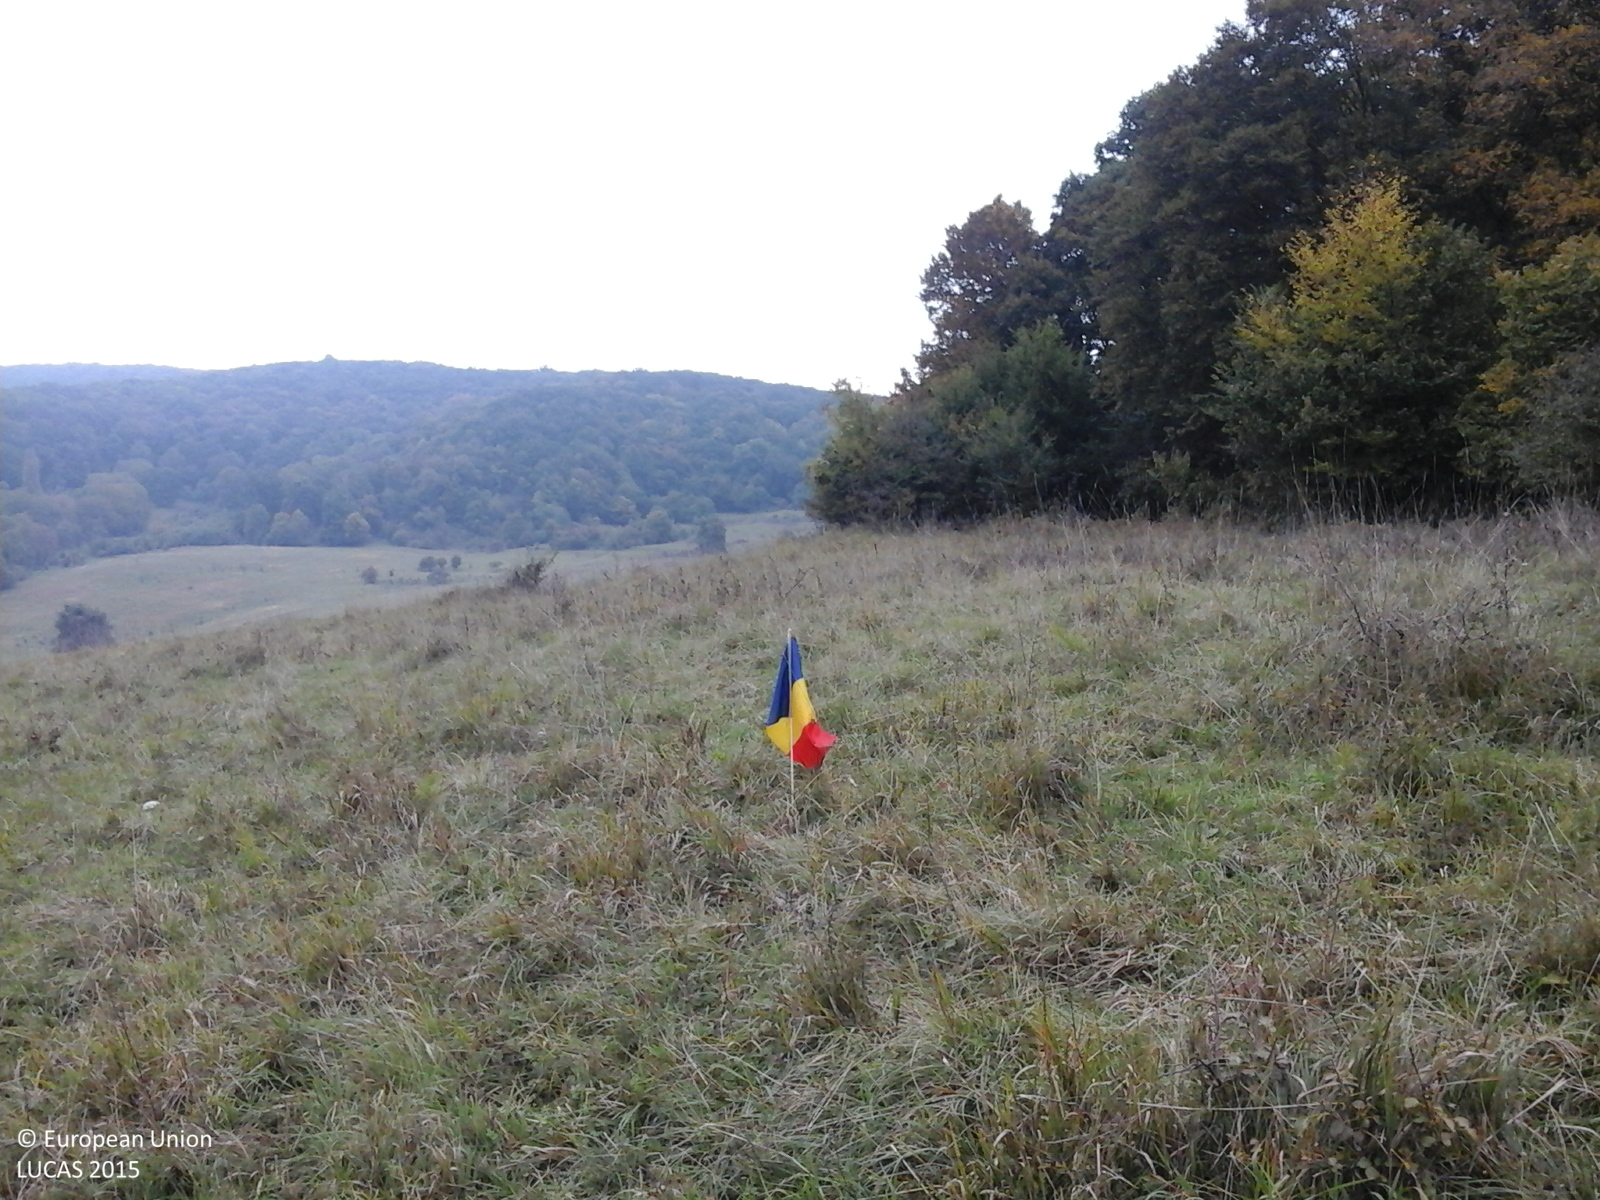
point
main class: Grassland
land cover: Grassland without tree/shrub cover
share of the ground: > 75 %
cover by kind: herbaceous plants 100 %
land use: Agriculture (excluding fallow land and kitchen gardens)
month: October
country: RO
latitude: 46.2672
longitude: 24.7919
